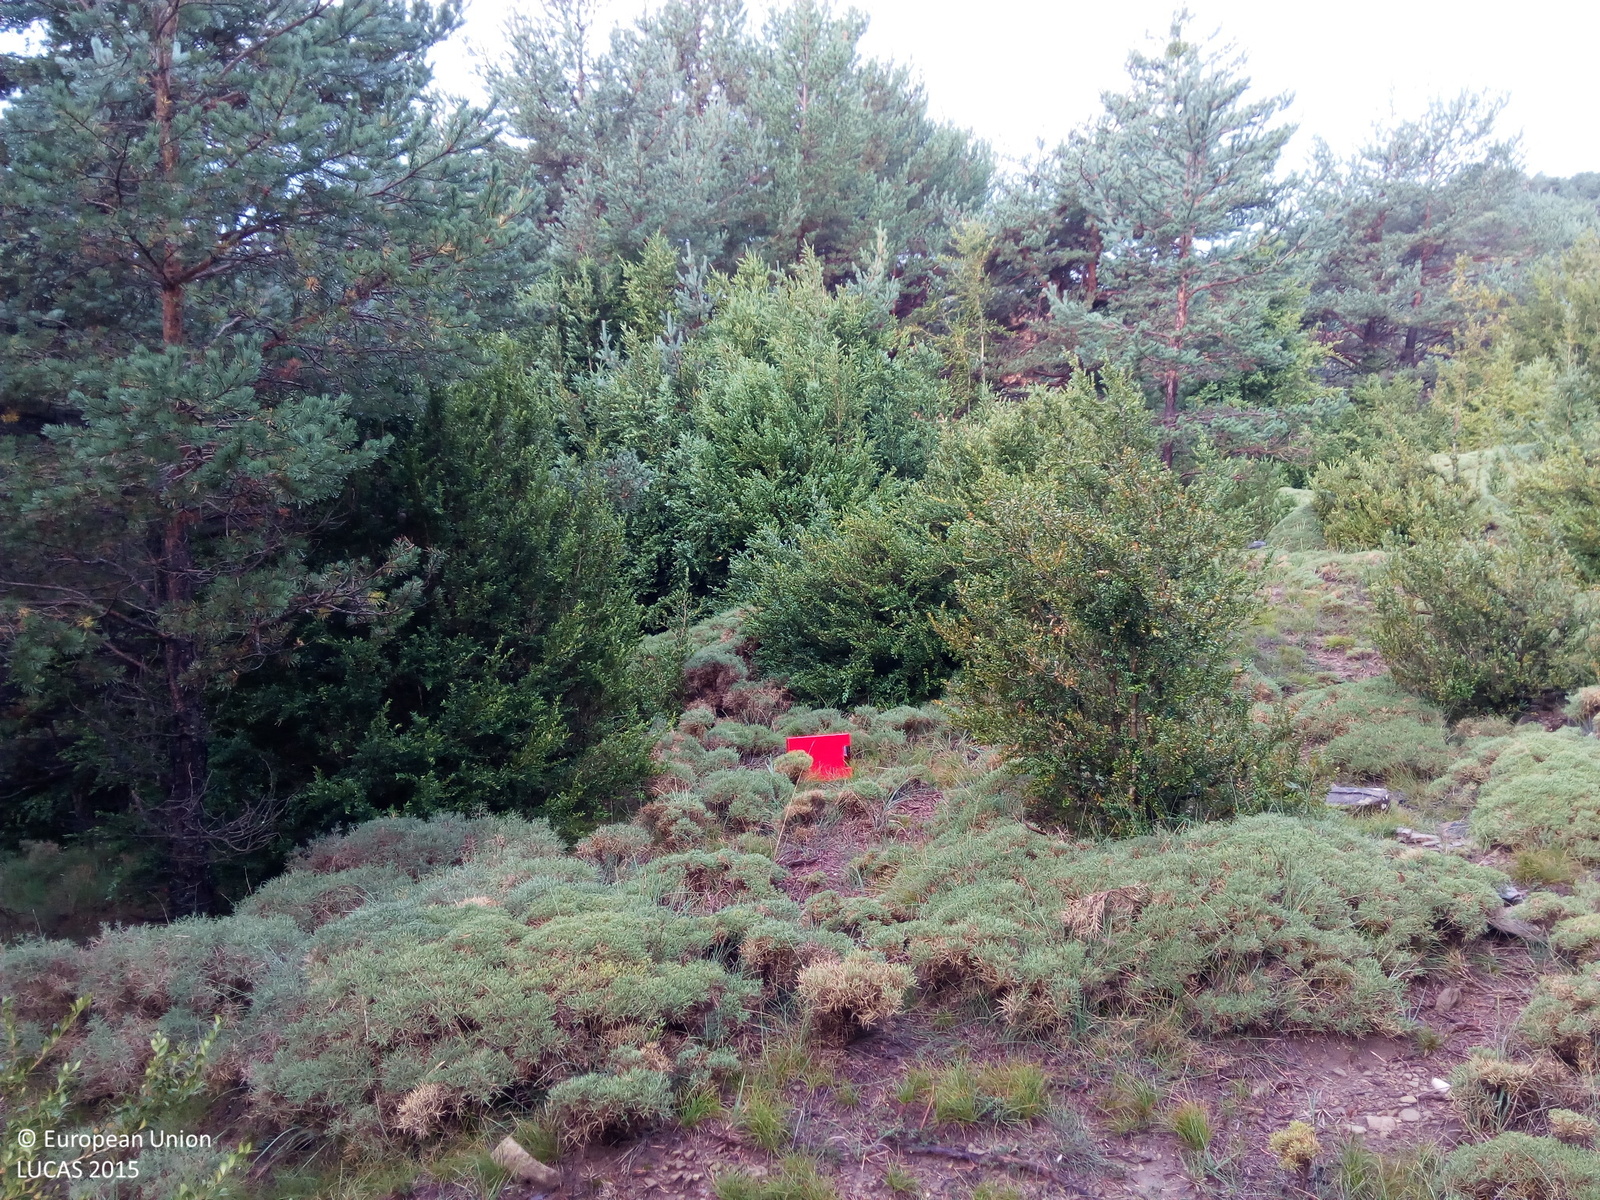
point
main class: Woodland
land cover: Pine dominated coniferous woodland
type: coniferous forest of the mediterranean region
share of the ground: > 75 %
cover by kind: coniferous forest trees 50 %, shrubs 40 %, herbaceous plants 10 %
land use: Agriculture (excluding fallow land and kitchen gardens)
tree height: > 5 m
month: September
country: ES
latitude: 42.4103
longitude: -0.0226
